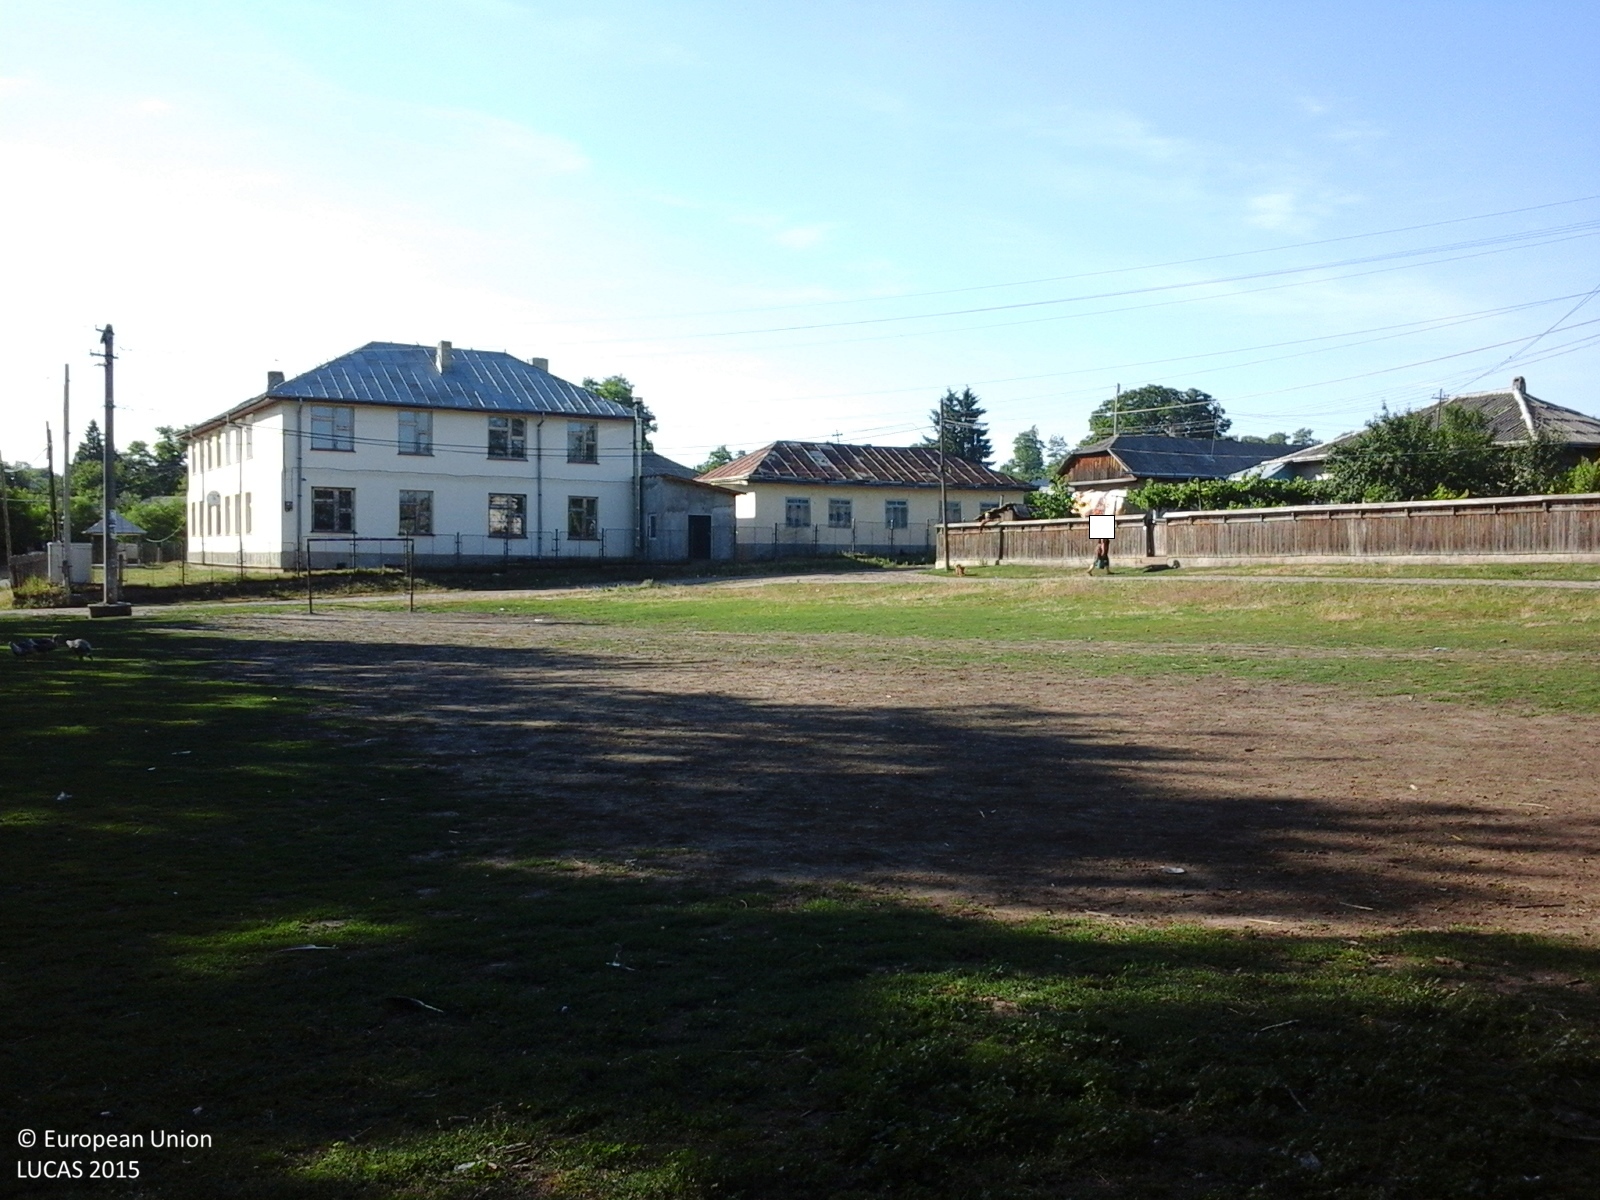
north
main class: Grassland
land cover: Grassland without tree/shrub cover
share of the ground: > 75 %
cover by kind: herbaceous plants 100 %
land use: Sport
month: June
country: RO
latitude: 47.4627
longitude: 27.0994
